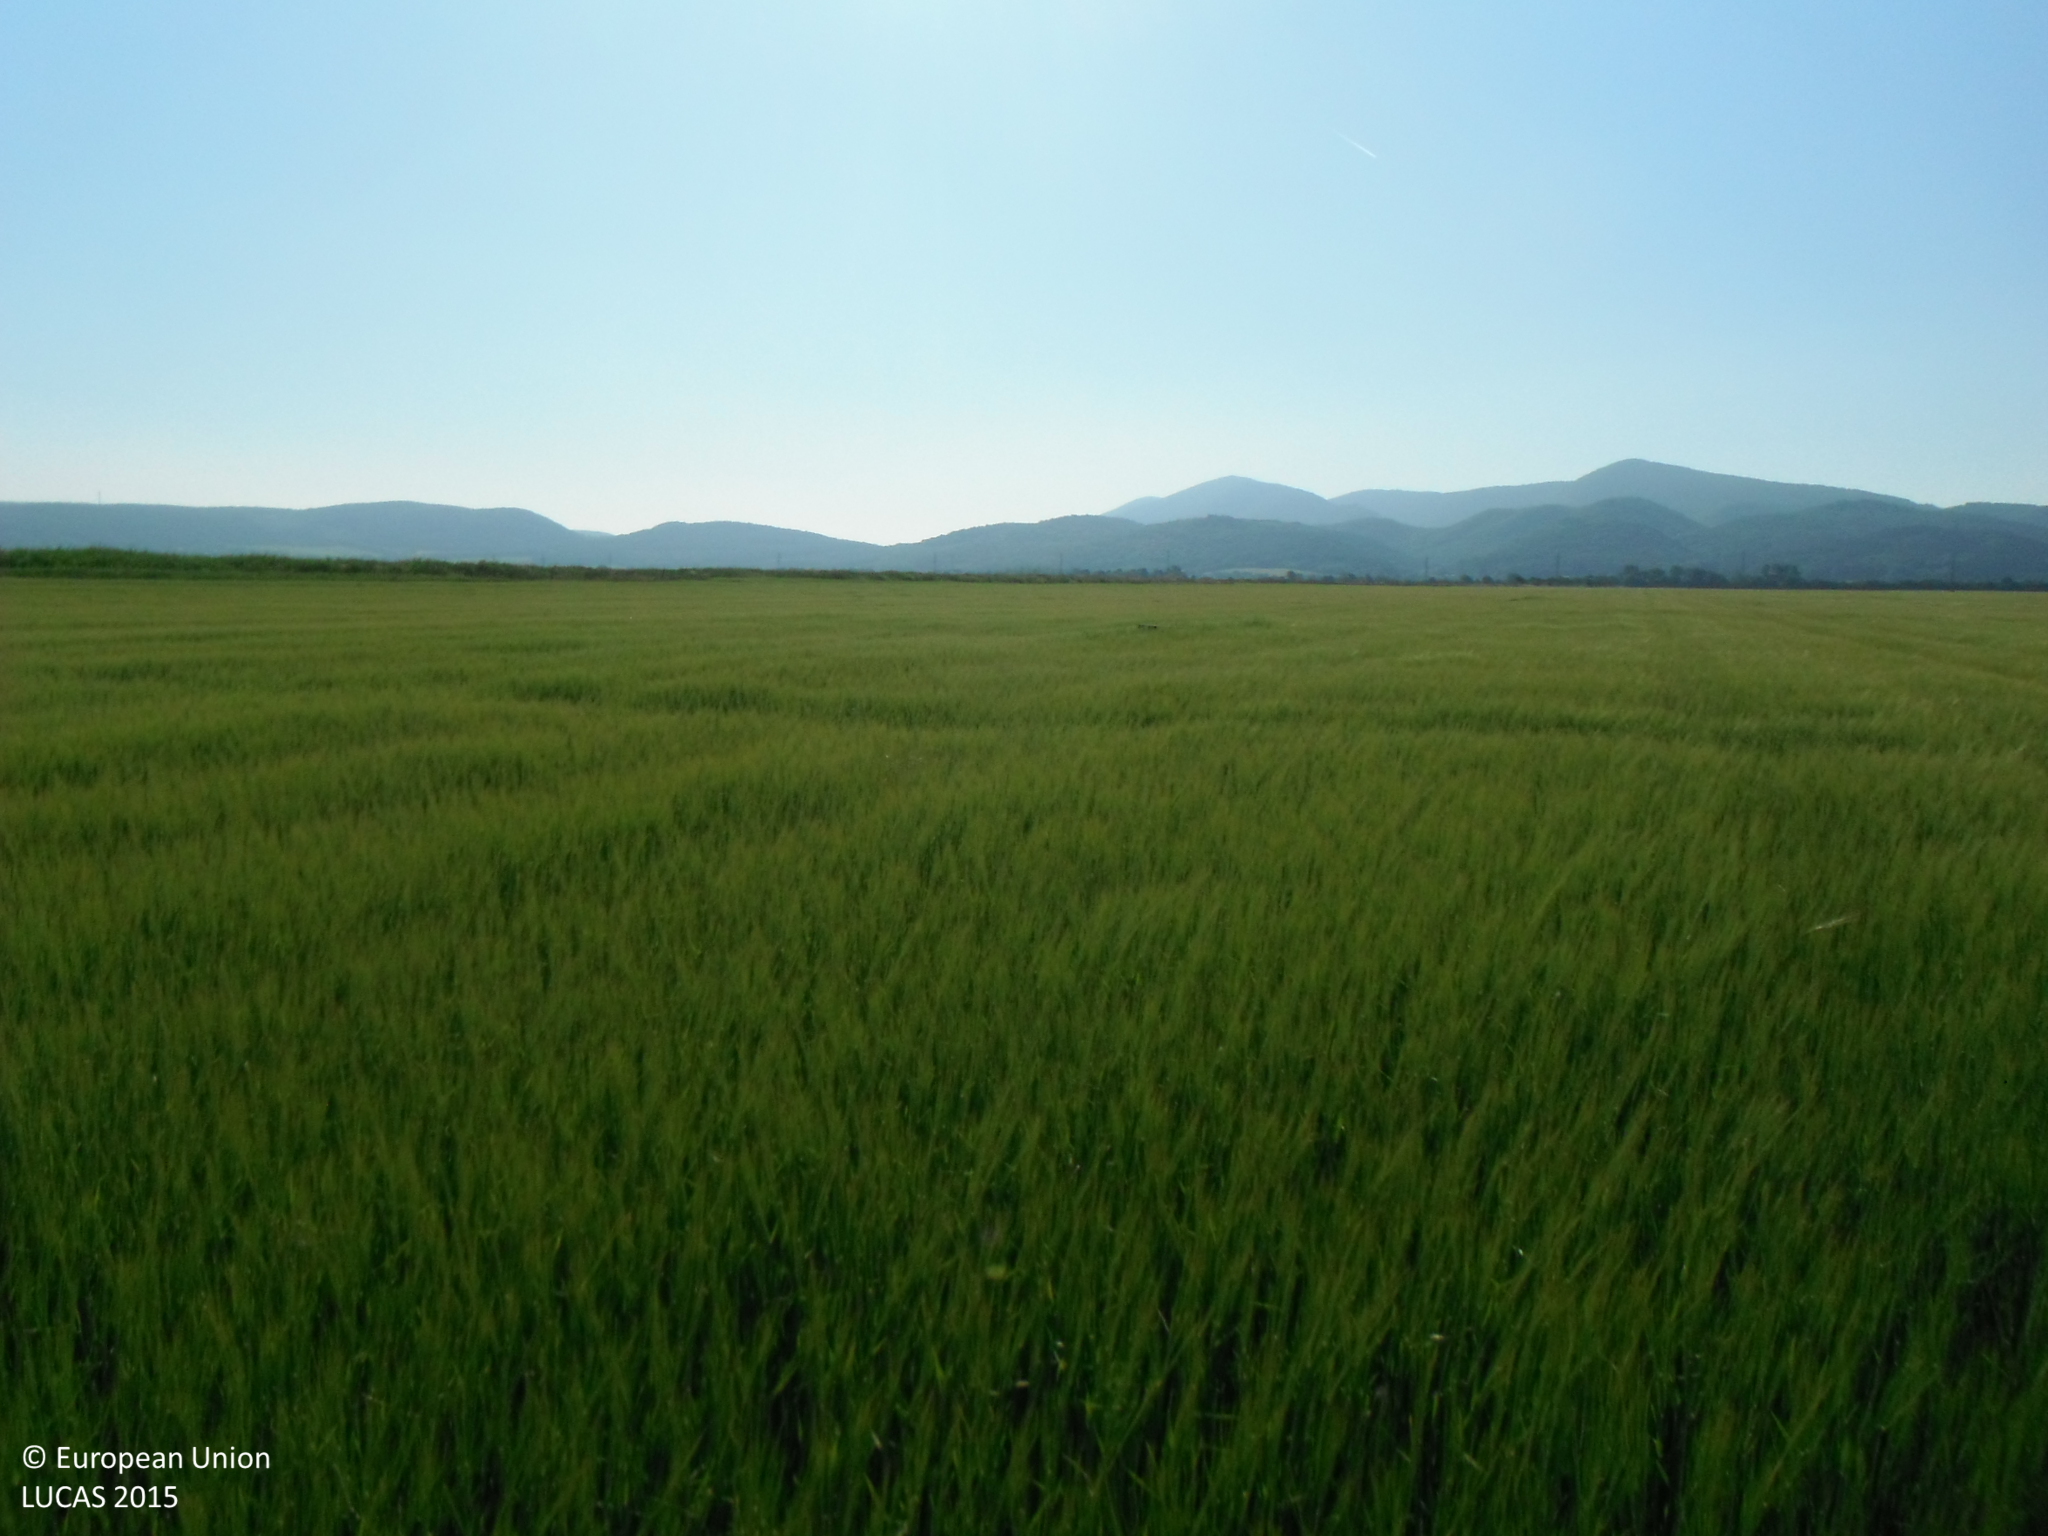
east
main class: Cropland
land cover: Barley
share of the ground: > 75 %
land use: Agriculture (excluding fallow land and kitchen gardens)
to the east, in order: Barley; Spontaneously vegetated surfaces; Ditches and canals; Spontaneously vegetated surfaces; Maize
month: June
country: SK
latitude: 48.5425
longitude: 17.2833
